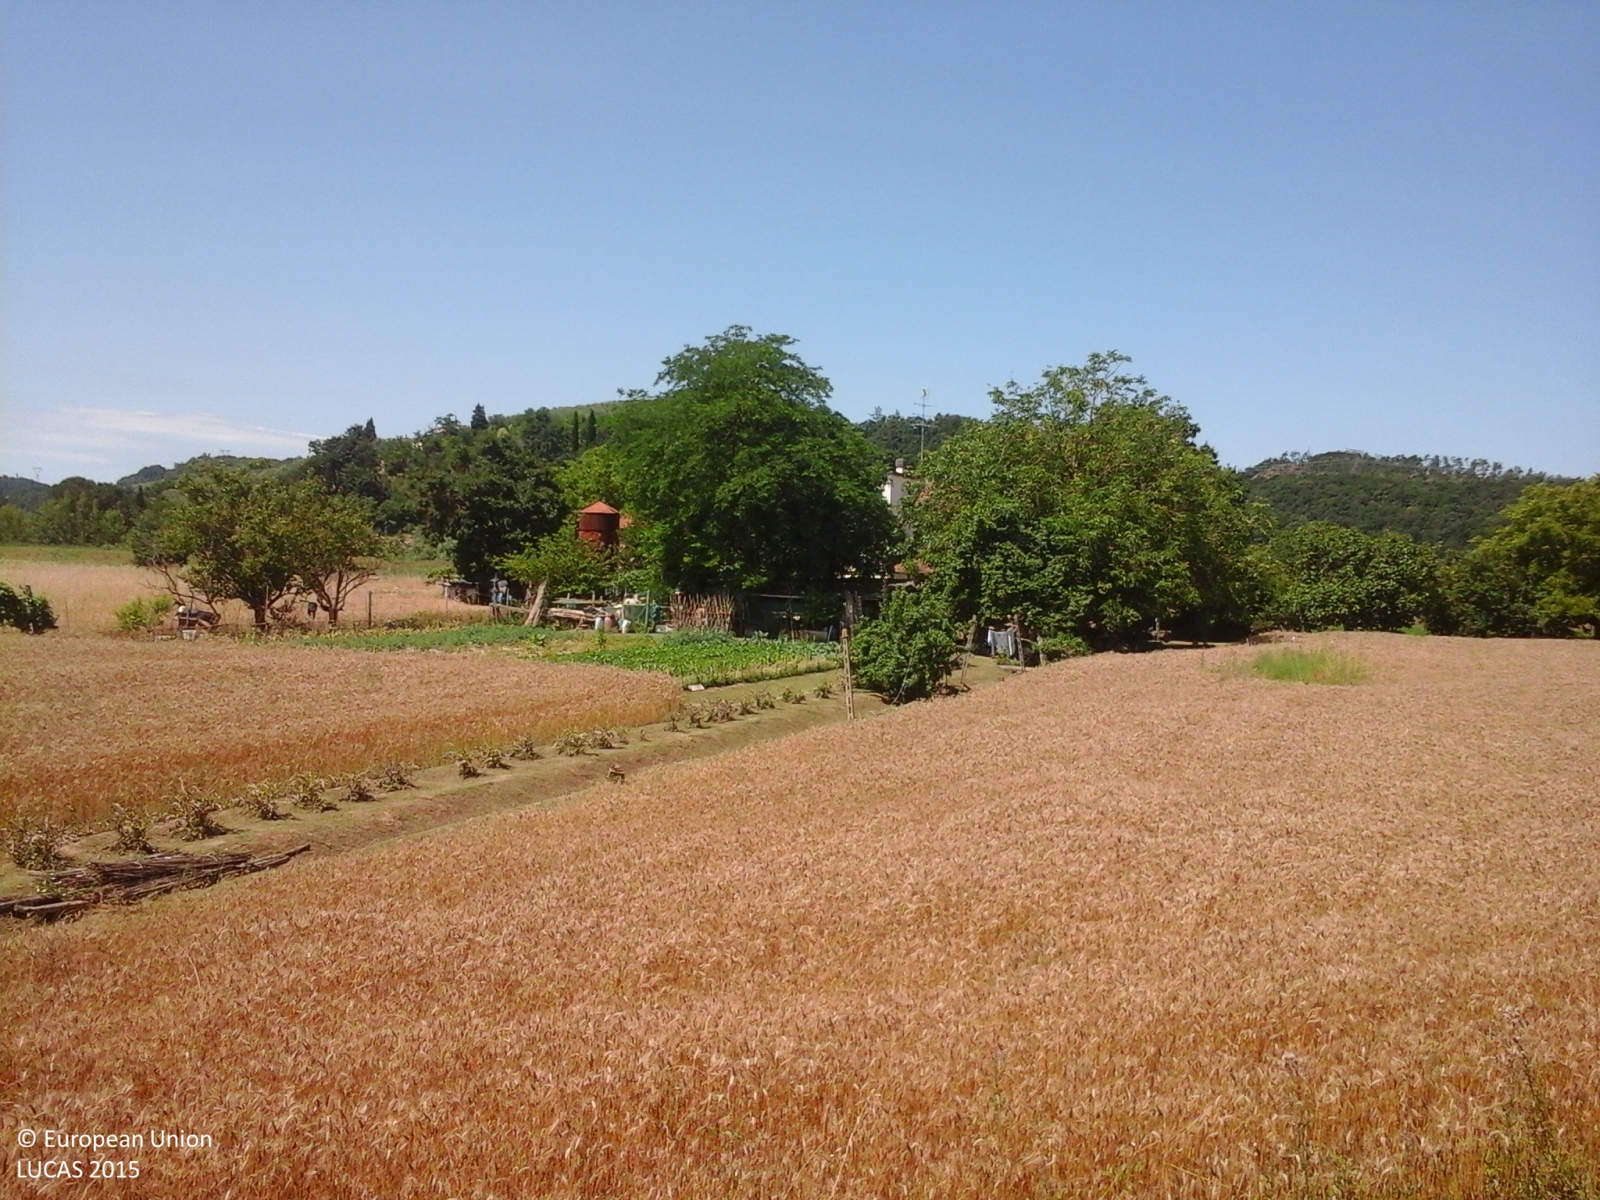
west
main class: Cropland
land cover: Durum wheat
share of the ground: > 75 %
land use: Agriculture (excluding fallow land and kitchen gardens)
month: June
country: IT
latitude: 43.6245
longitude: 10.9517
